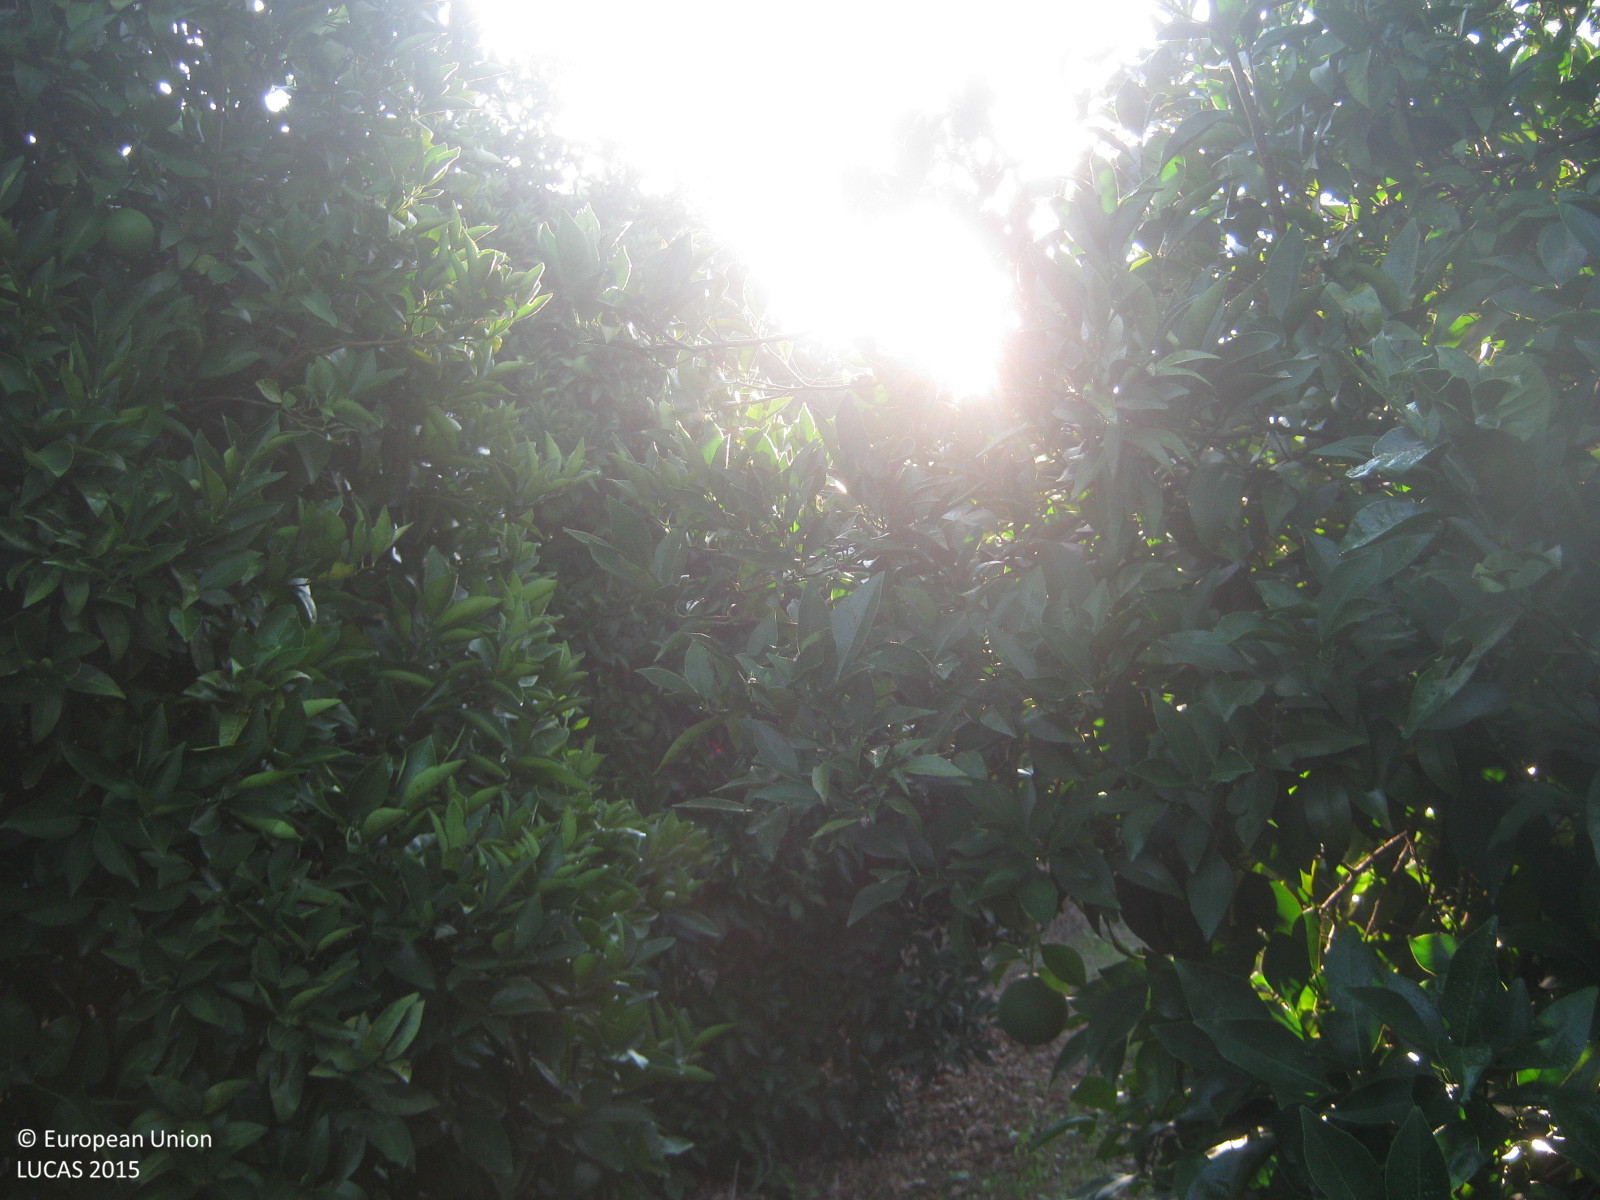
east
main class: Cropland
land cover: Oranges
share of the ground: > 75 %
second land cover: Spontaneously vegetated surfaces
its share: 25 - 50 %
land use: Agriculture (excluding fallow land and kitchen gardens)
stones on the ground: < 10 %
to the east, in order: Oranges; Spontaneously vegetated surfaces; Electric lines; Oranges; Artificial constructions in urban areas; Floriculture and ornamental plants; Artificial constructions in urban areas; Other bare soil; Fences; Grass margins; Paved roads, cycling and walking lanes; Electric lines; Paved roads, cycling and walking lanes; Grass margins; Oranges; Electric lines; Oranges; Electric lines; Oranges; Tracks; Oranges; Electric lines; Oranges; Fences; Broadleaved woodland
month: October
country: GR
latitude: 37.6149
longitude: 22.7793
